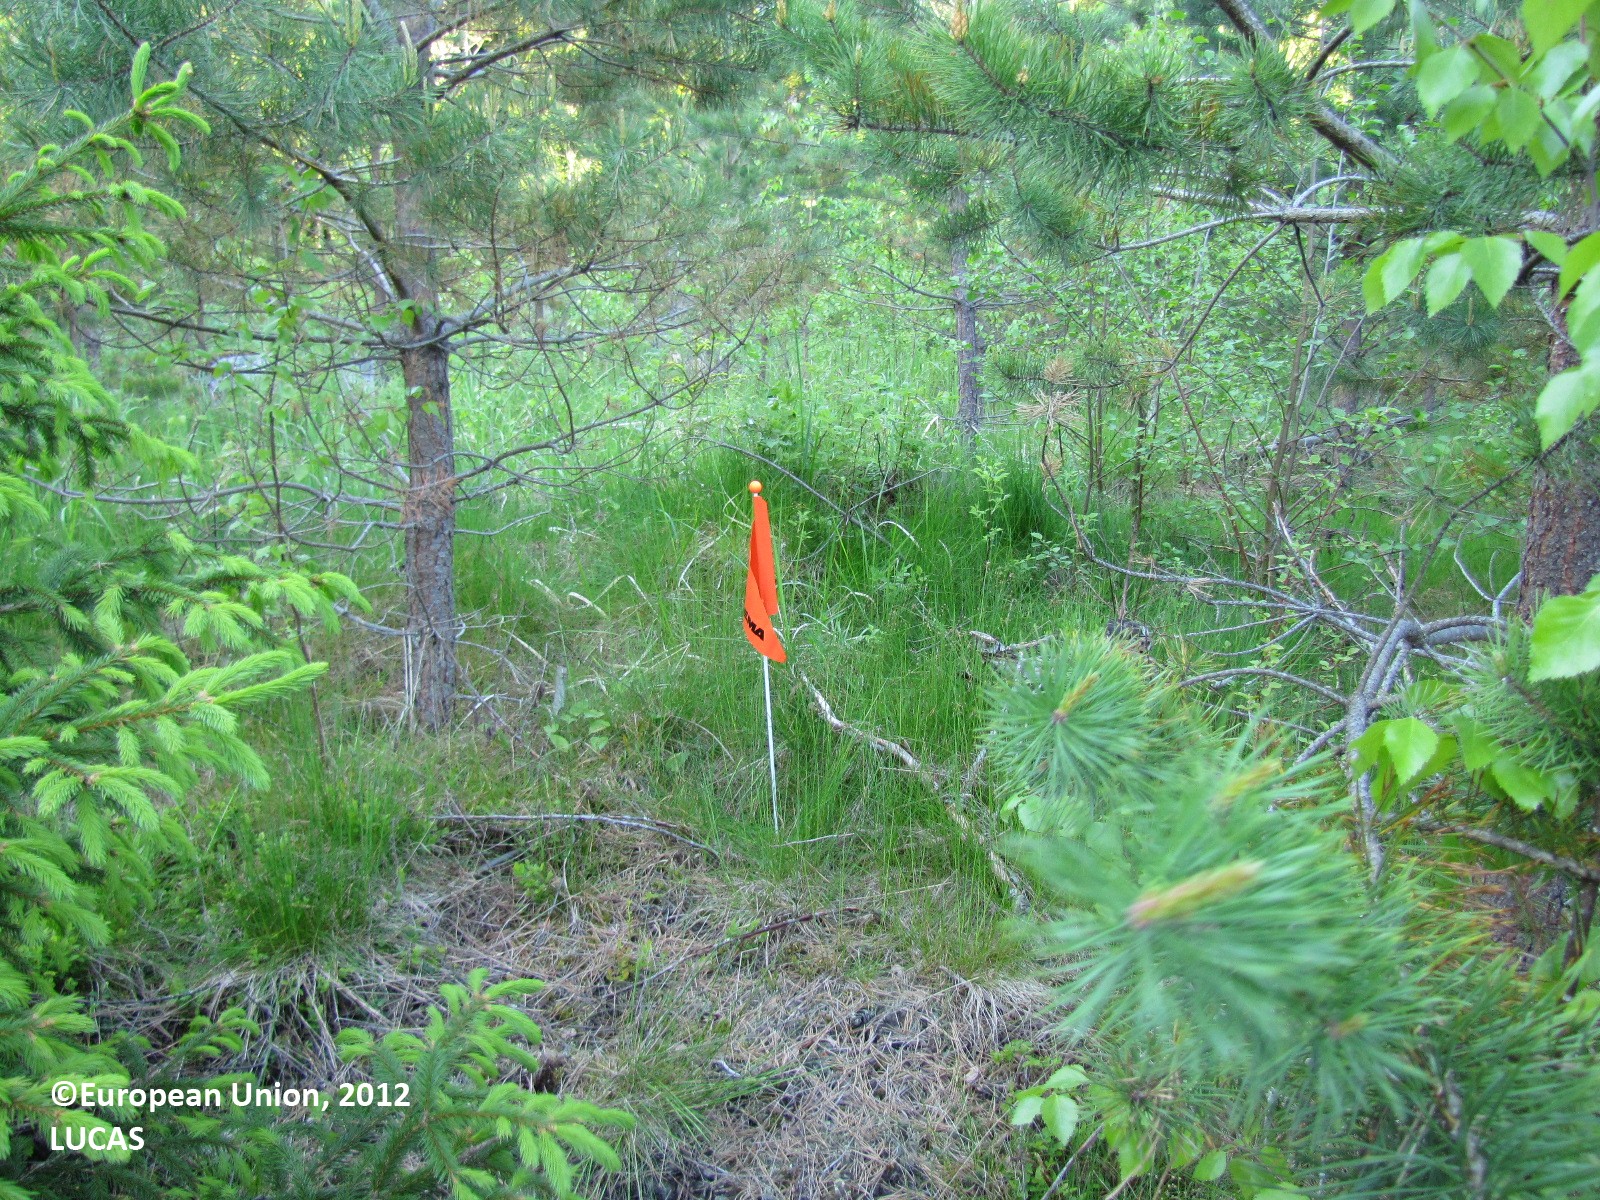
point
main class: Woodland
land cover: Pine dominated mixed woodland
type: boreal forest
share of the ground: 25 - 50 %
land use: Forestry
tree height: < 5 m
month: June
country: FI
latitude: 61.2337
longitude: 22.8682
